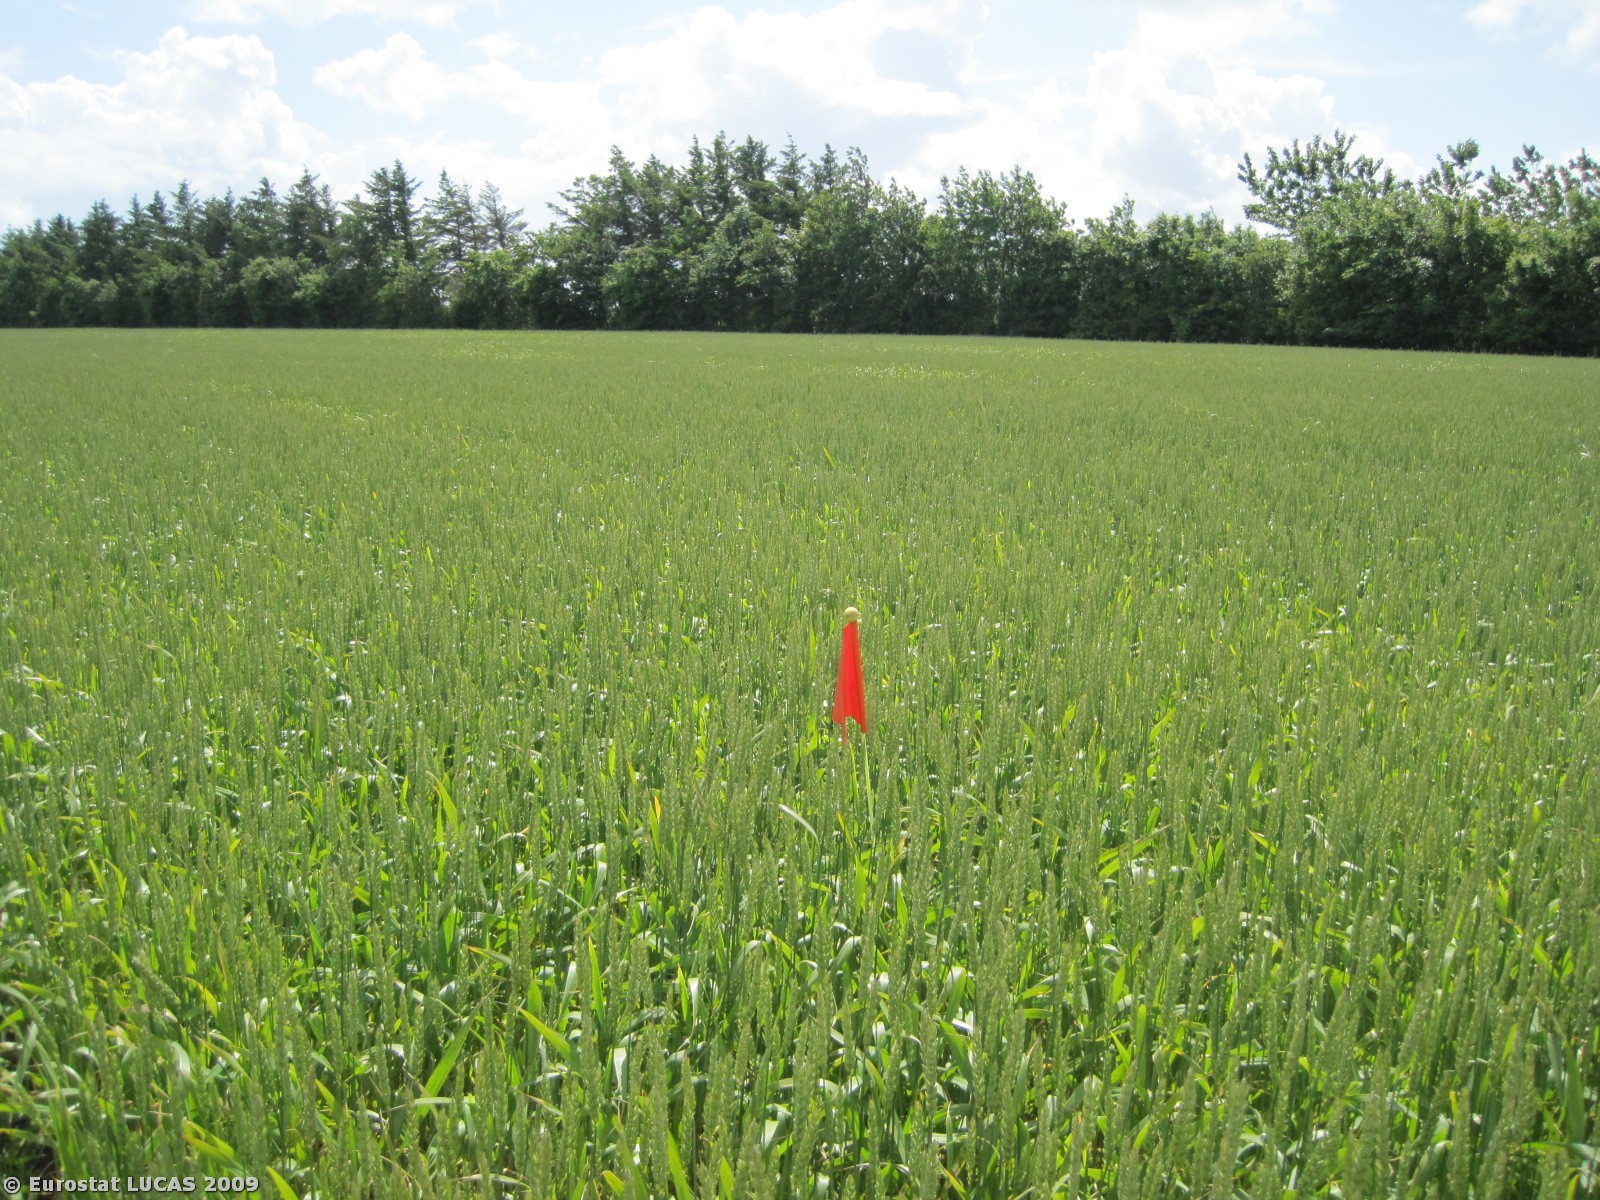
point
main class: Cropland
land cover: Common wheat
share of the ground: > 75 %
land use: Agriculture (excluding fallow land and kitchen gardens)
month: June
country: DK
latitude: 57.0661
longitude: 9.1931
